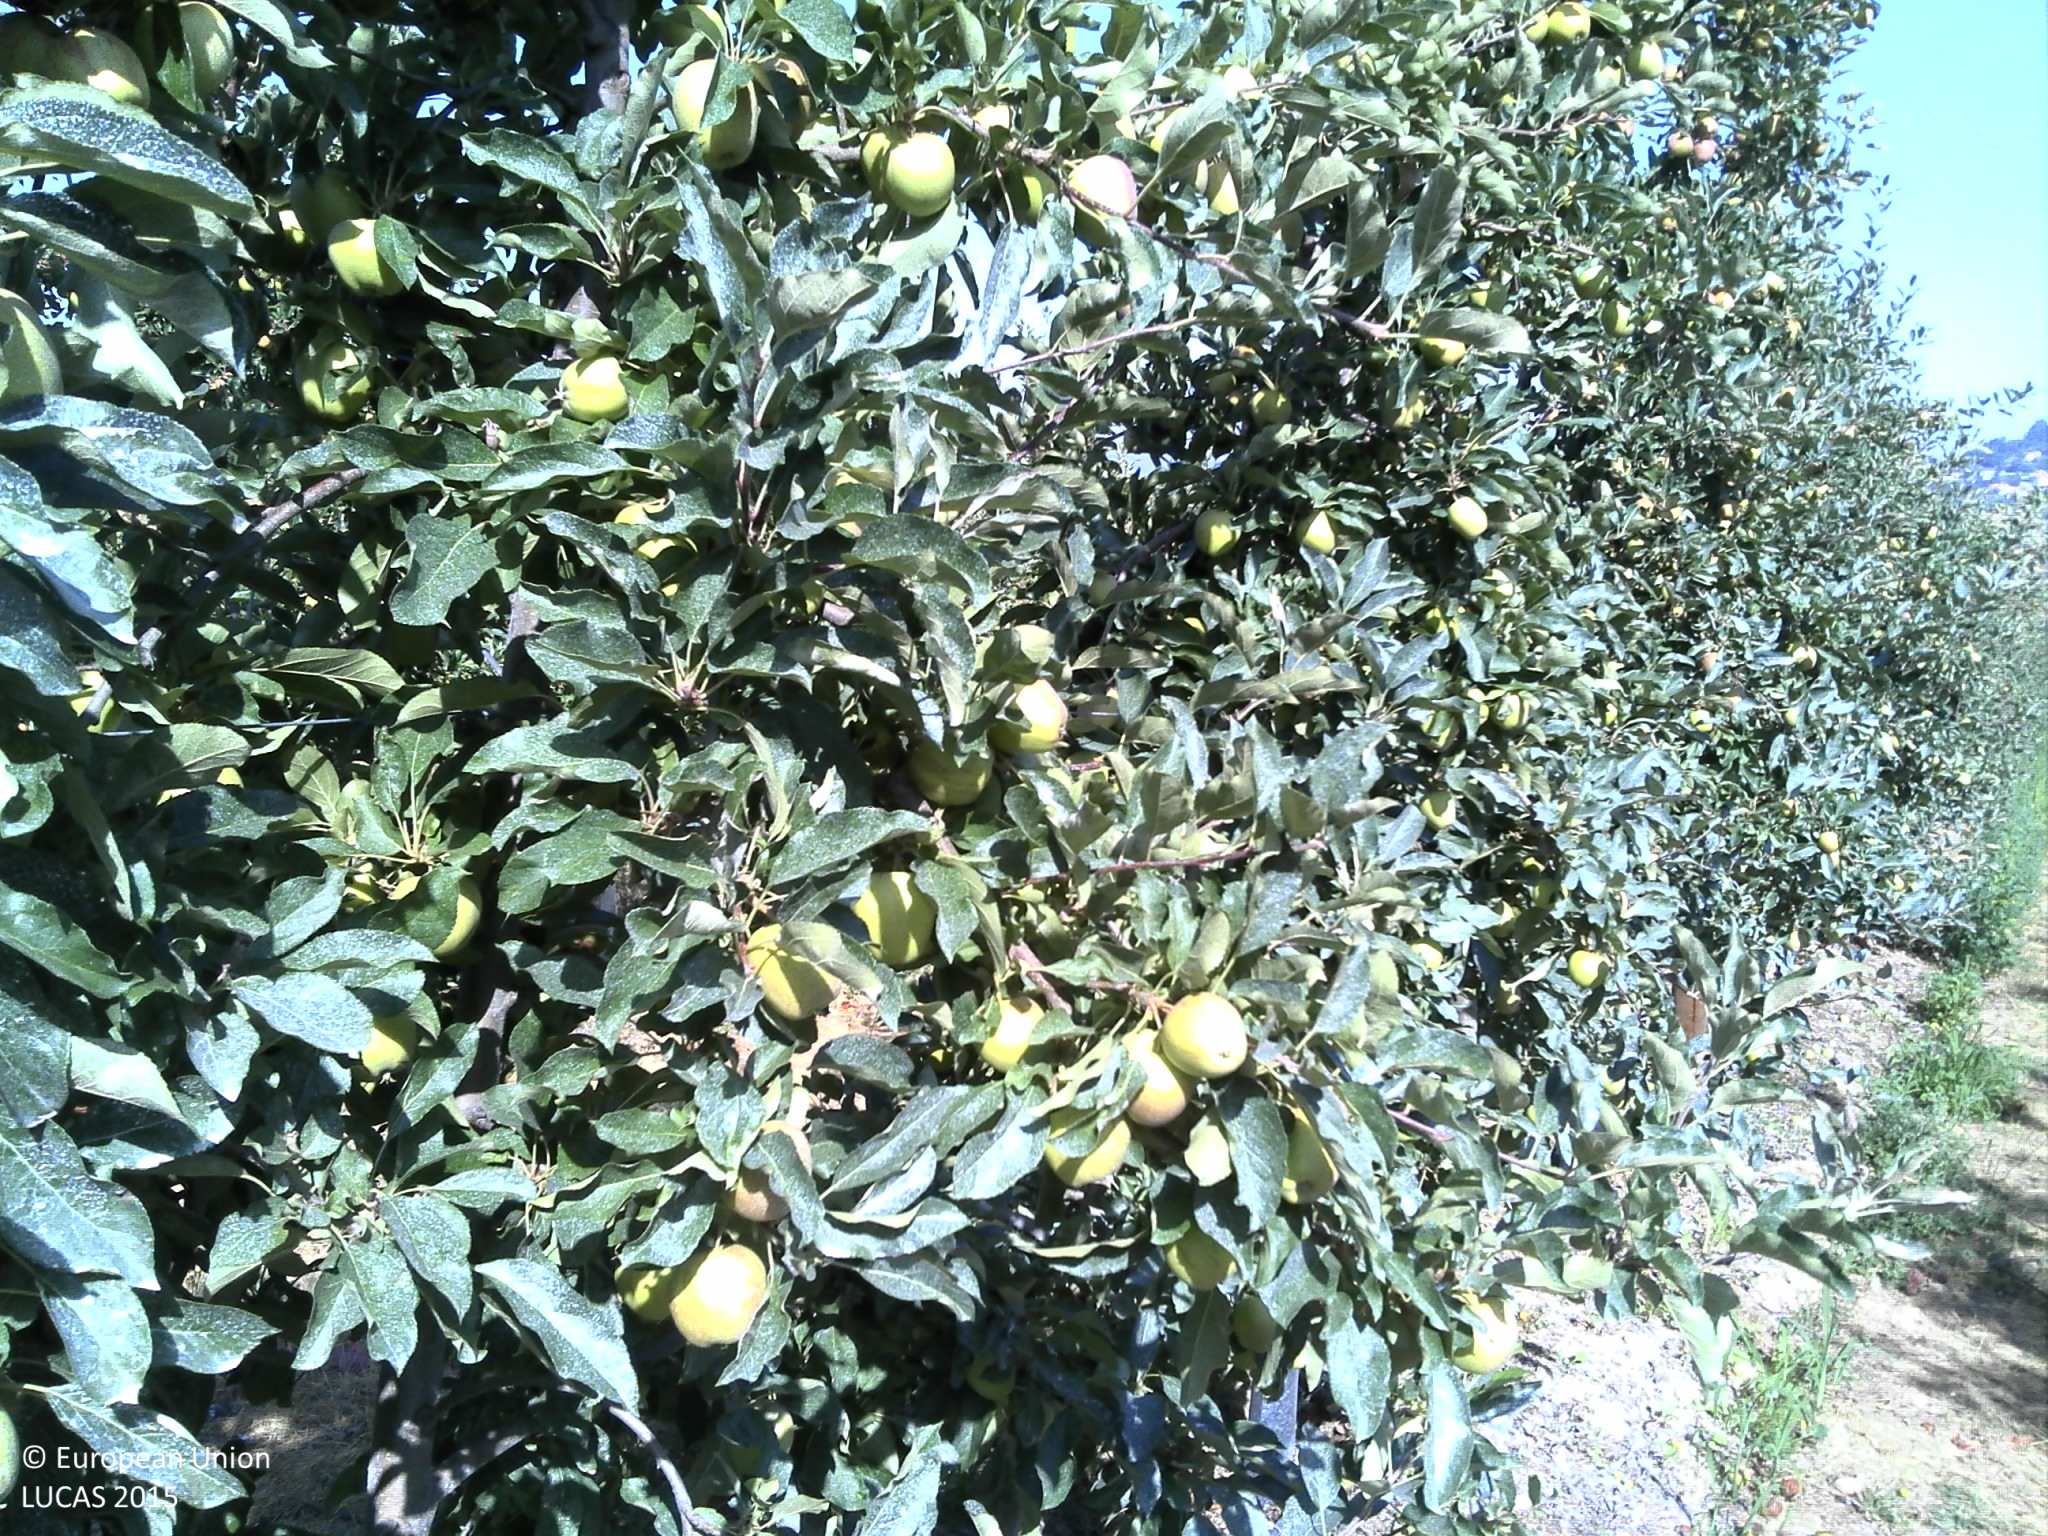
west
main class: Cropland
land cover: Apple fruit
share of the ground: 25 - 50 %
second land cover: Grassland without tree/shrub cover
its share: 10 - 25 %
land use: Agriculture (excluding fallow land and kitchen gardens)
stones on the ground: < 10 %
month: July
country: PT
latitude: 41.0509
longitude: -7.4538
